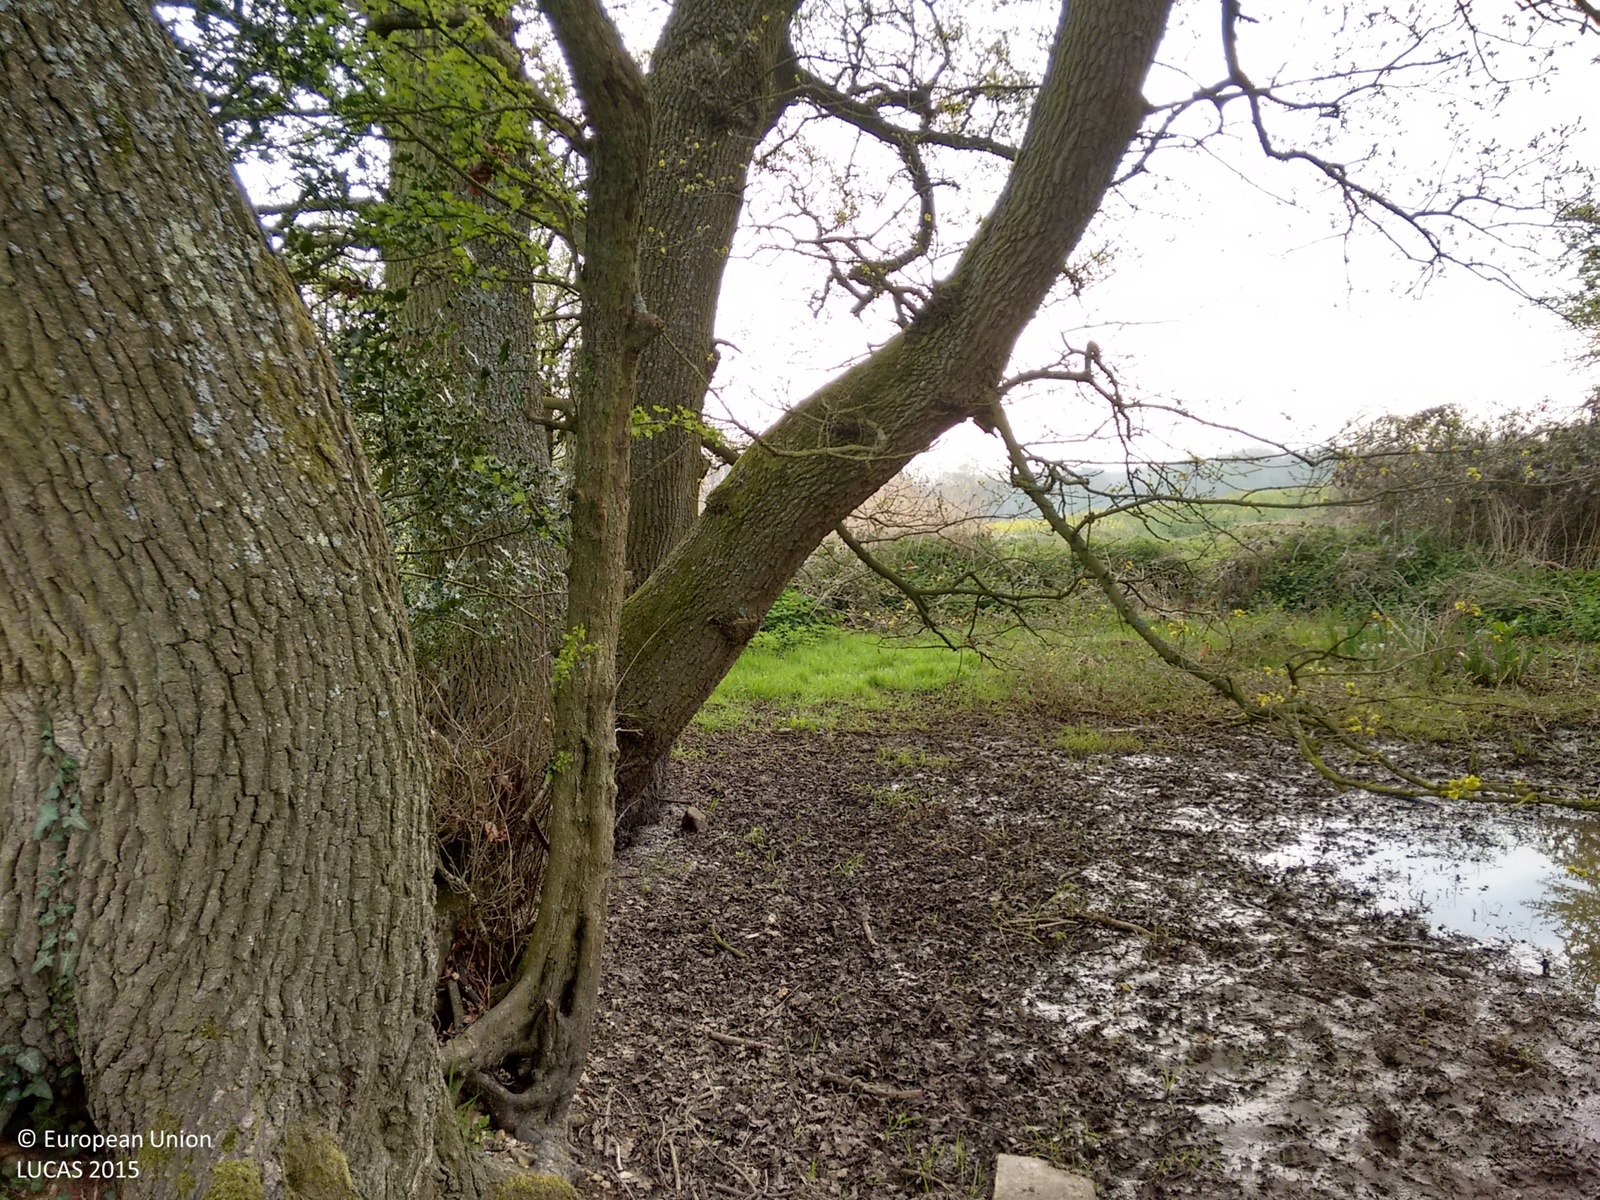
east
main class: Woodland
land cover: Broadleaved woodland
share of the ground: > 75 %
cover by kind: broadleaved forest trees 95 %, consolidated bare surface 5 %
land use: Semi-natural and natural areas not in use
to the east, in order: Broadleaved woodland; Grassland without tree/shrub cover; Rape and turnip rape; Tracks; Grass margins; Dry pulses
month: April
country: GB
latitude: 51.6544
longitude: -0.7229
